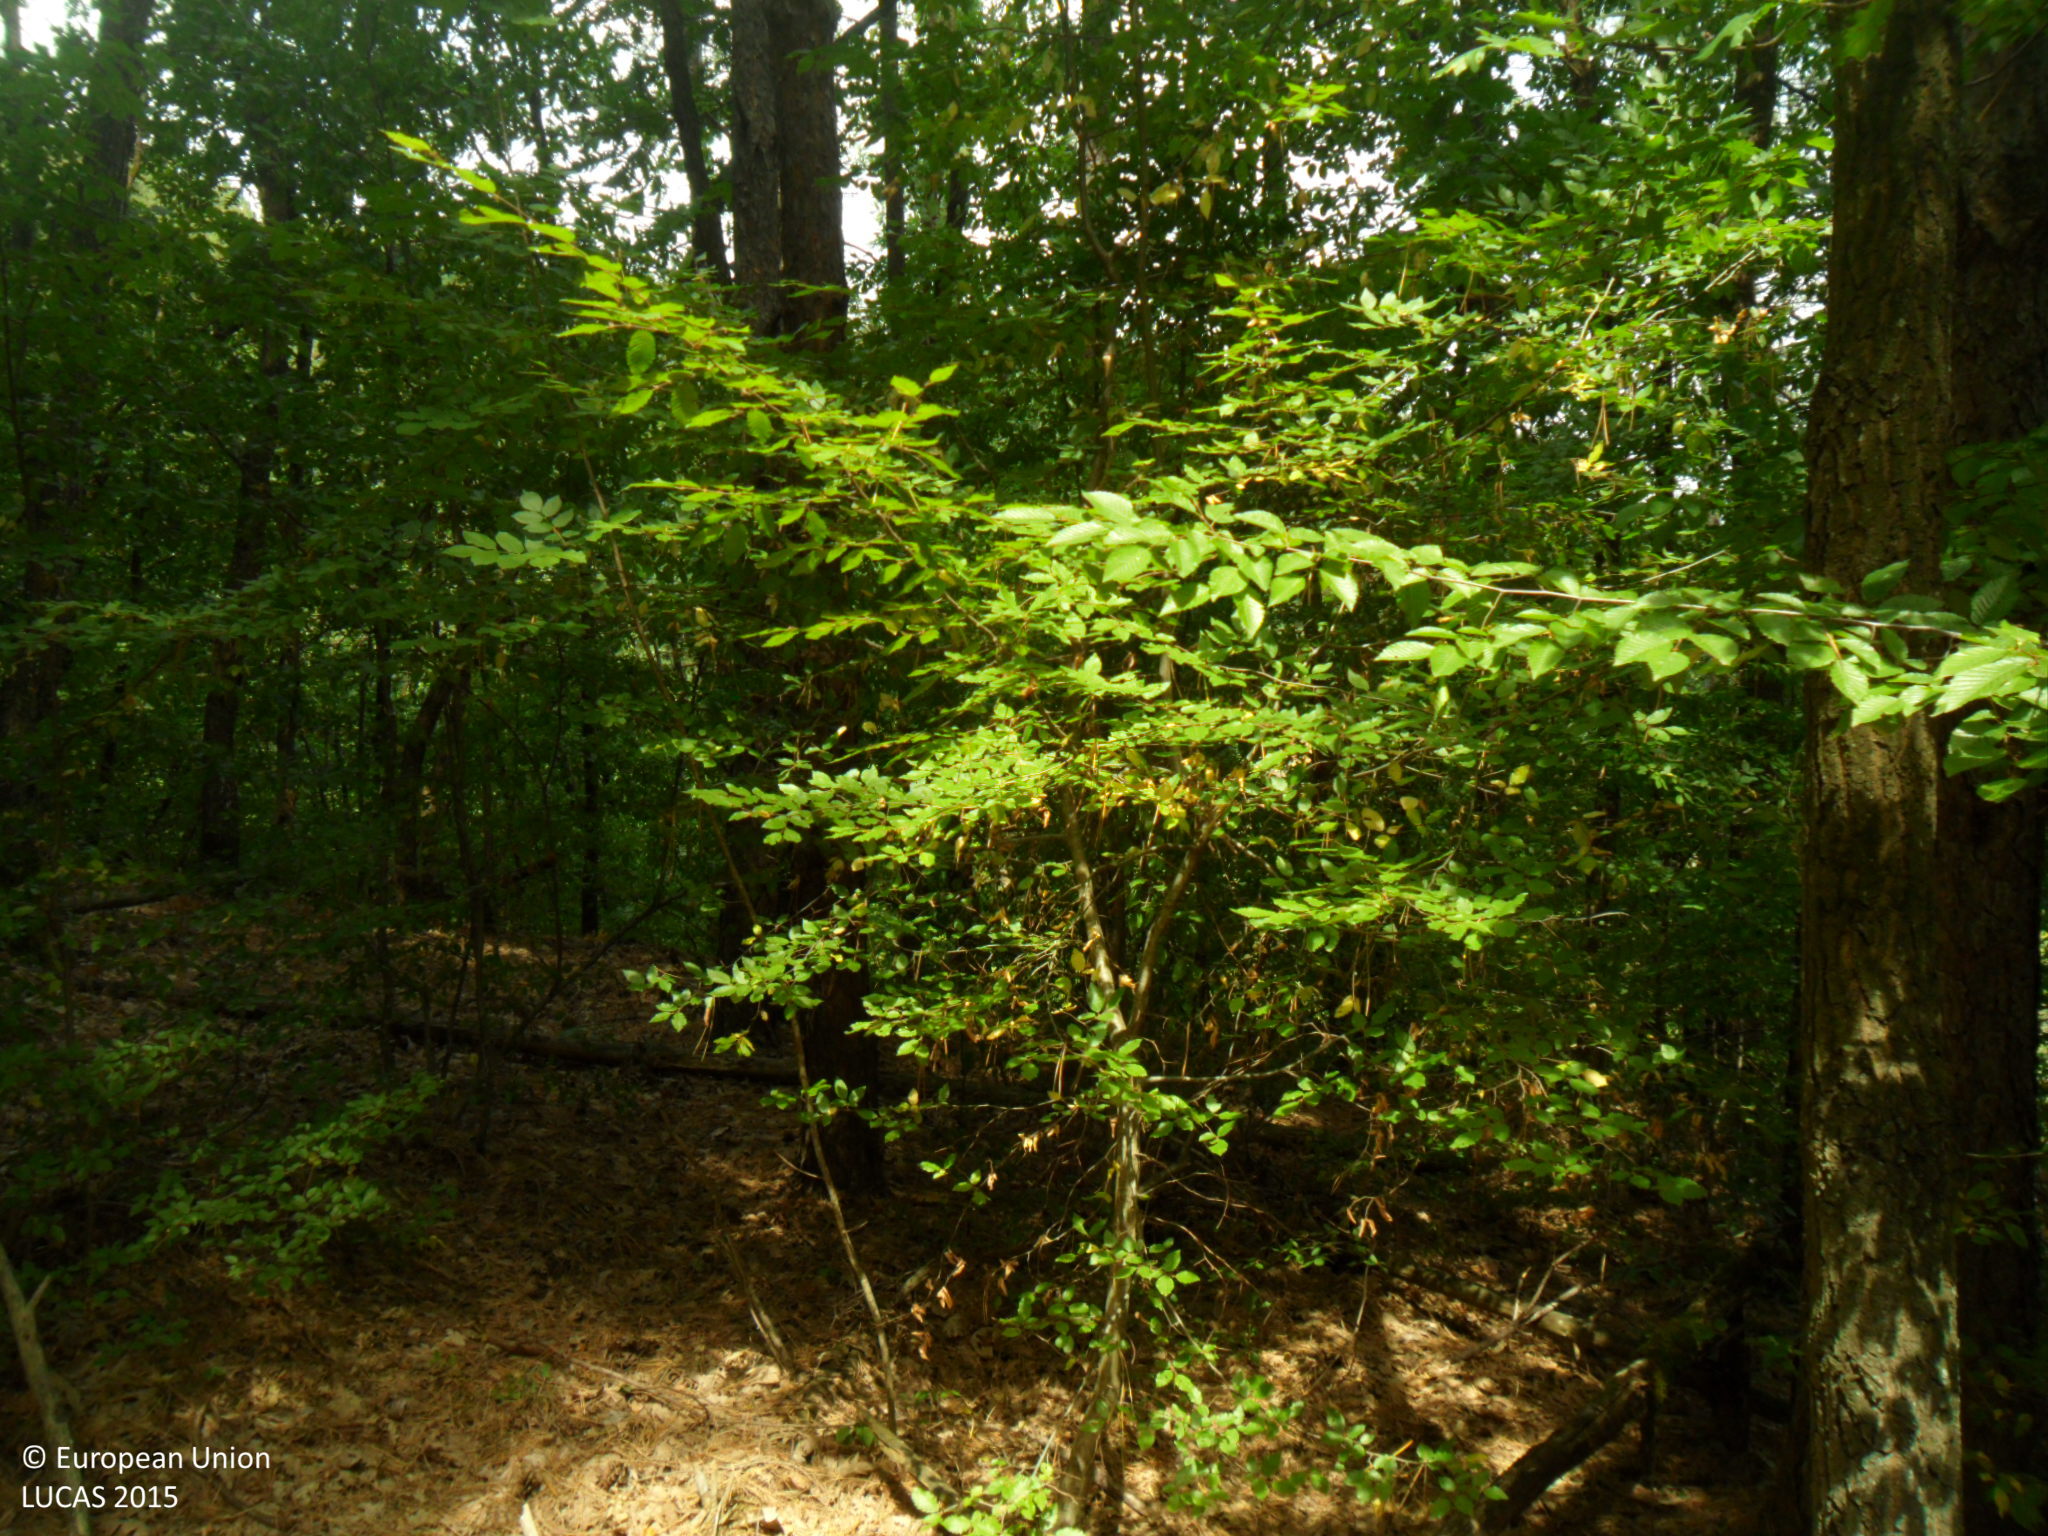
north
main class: Woodland
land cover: Pine dominated mixed woodland
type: hemiboreal forest and nemoral coniferous forest and mixed broadleaved-coniferous forest
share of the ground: > 75 %
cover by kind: coniferous forest trees 50 %, broadleaved forest trees 50 %
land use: Forestry
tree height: > 5 m
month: August
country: BG
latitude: 42.9742
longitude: 26.7684
